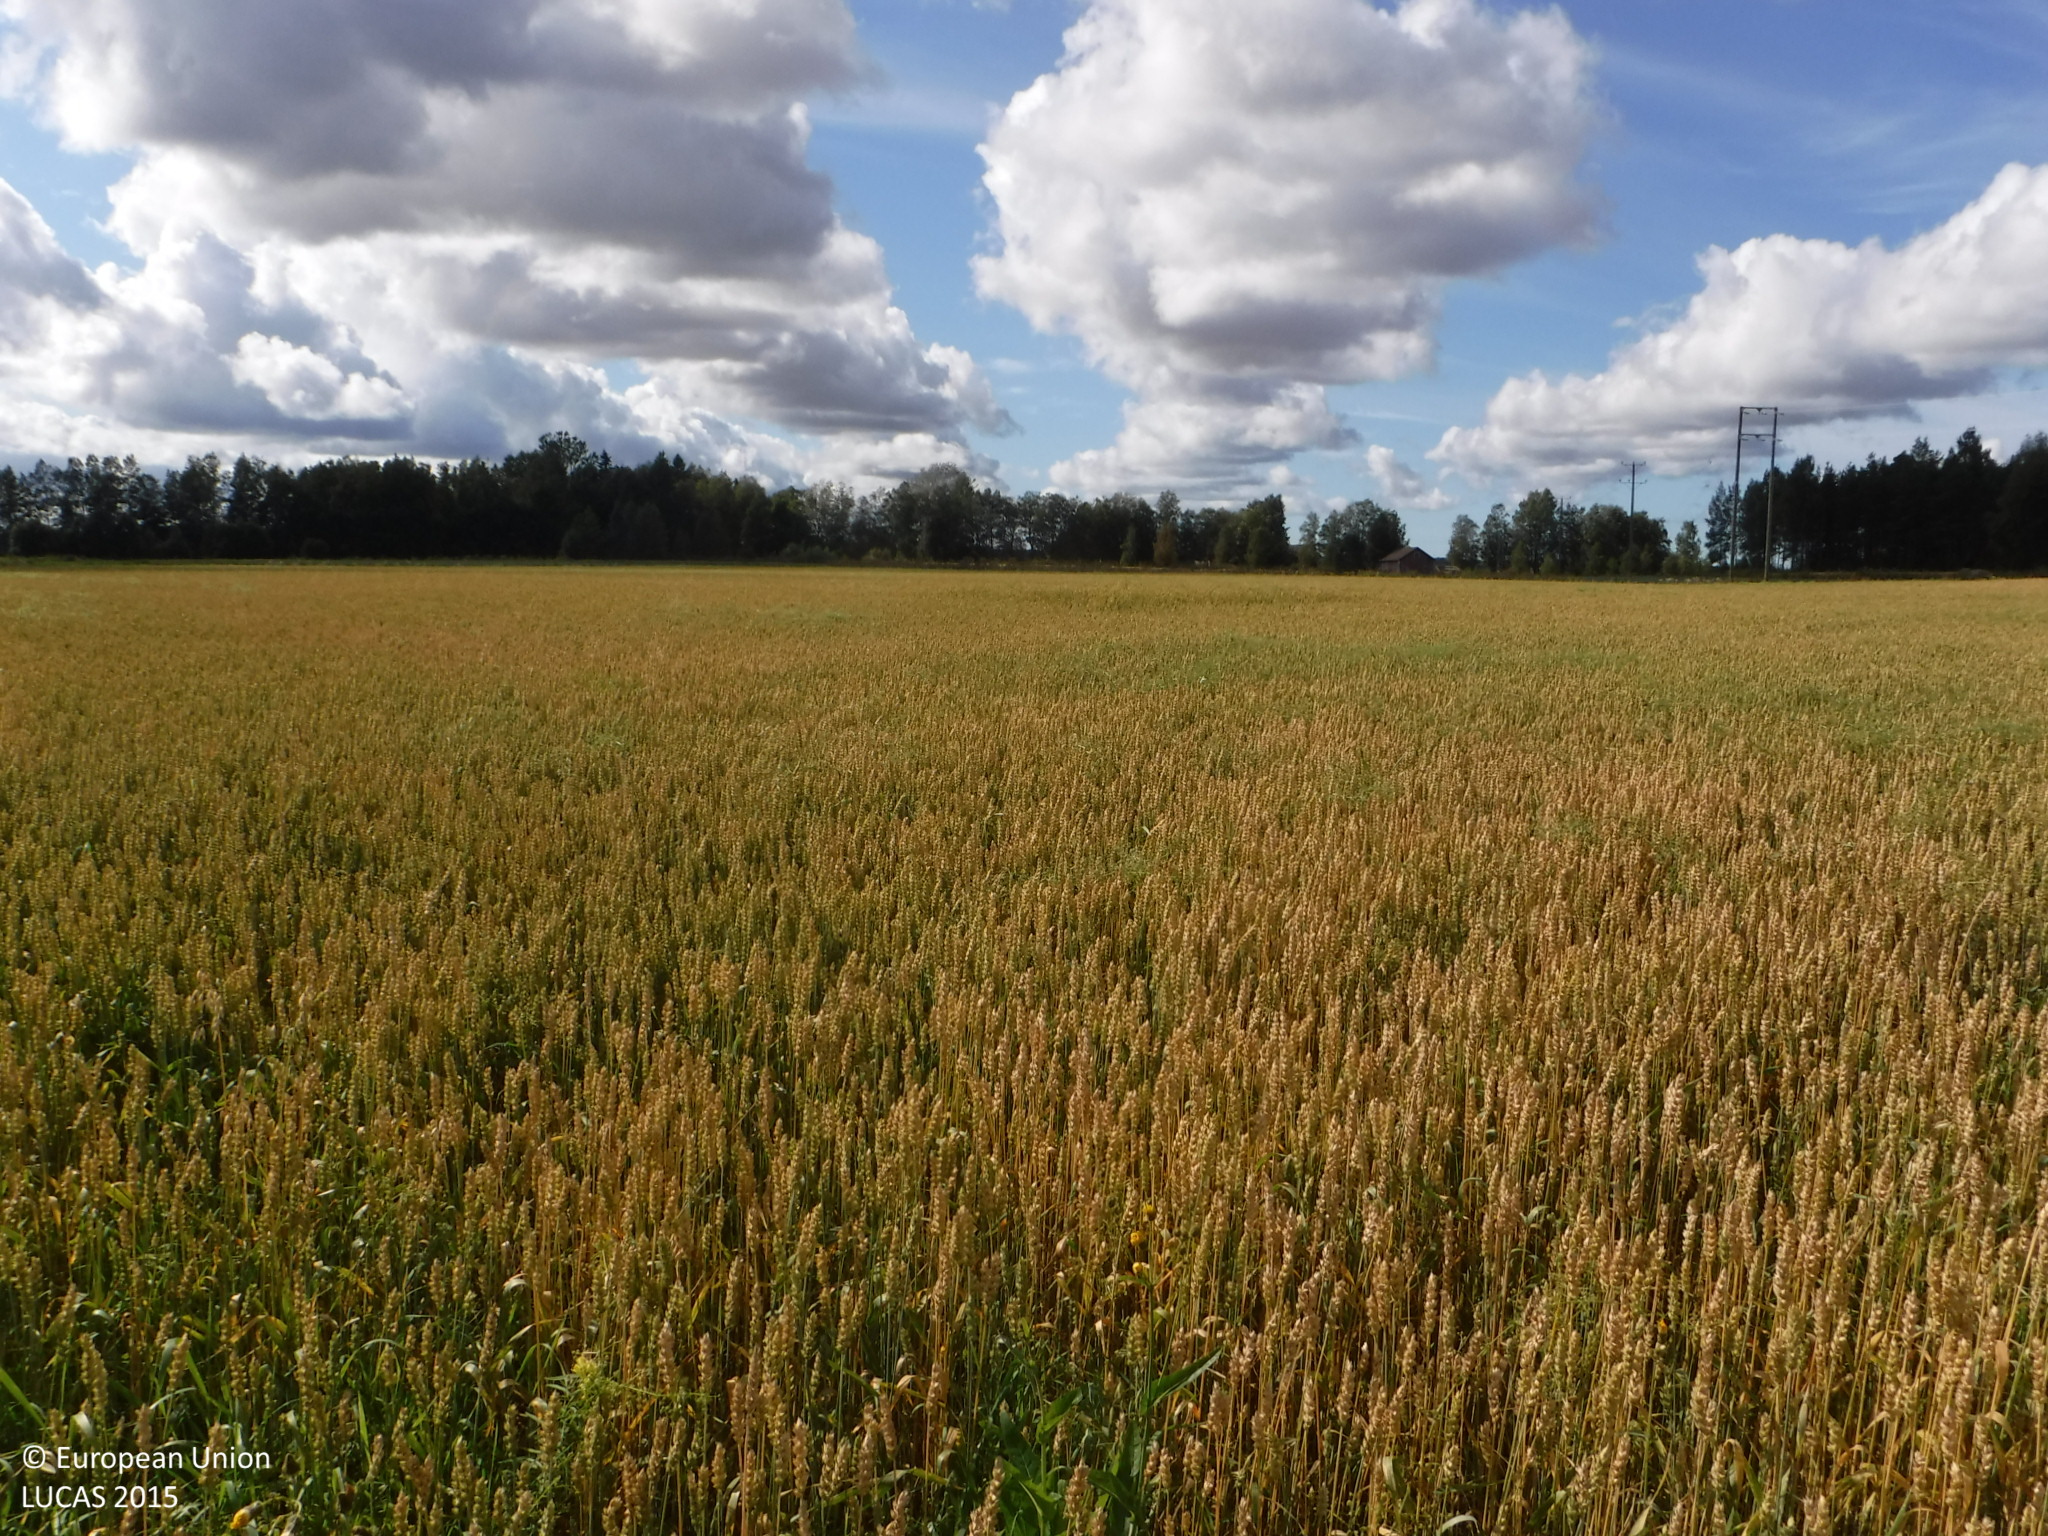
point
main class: Cropland
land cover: Common wheat
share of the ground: > 75 %
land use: Agriculture (excluding fallow land and kitchen gardens)
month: August
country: FI
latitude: 61.2239
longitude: 21.9196
